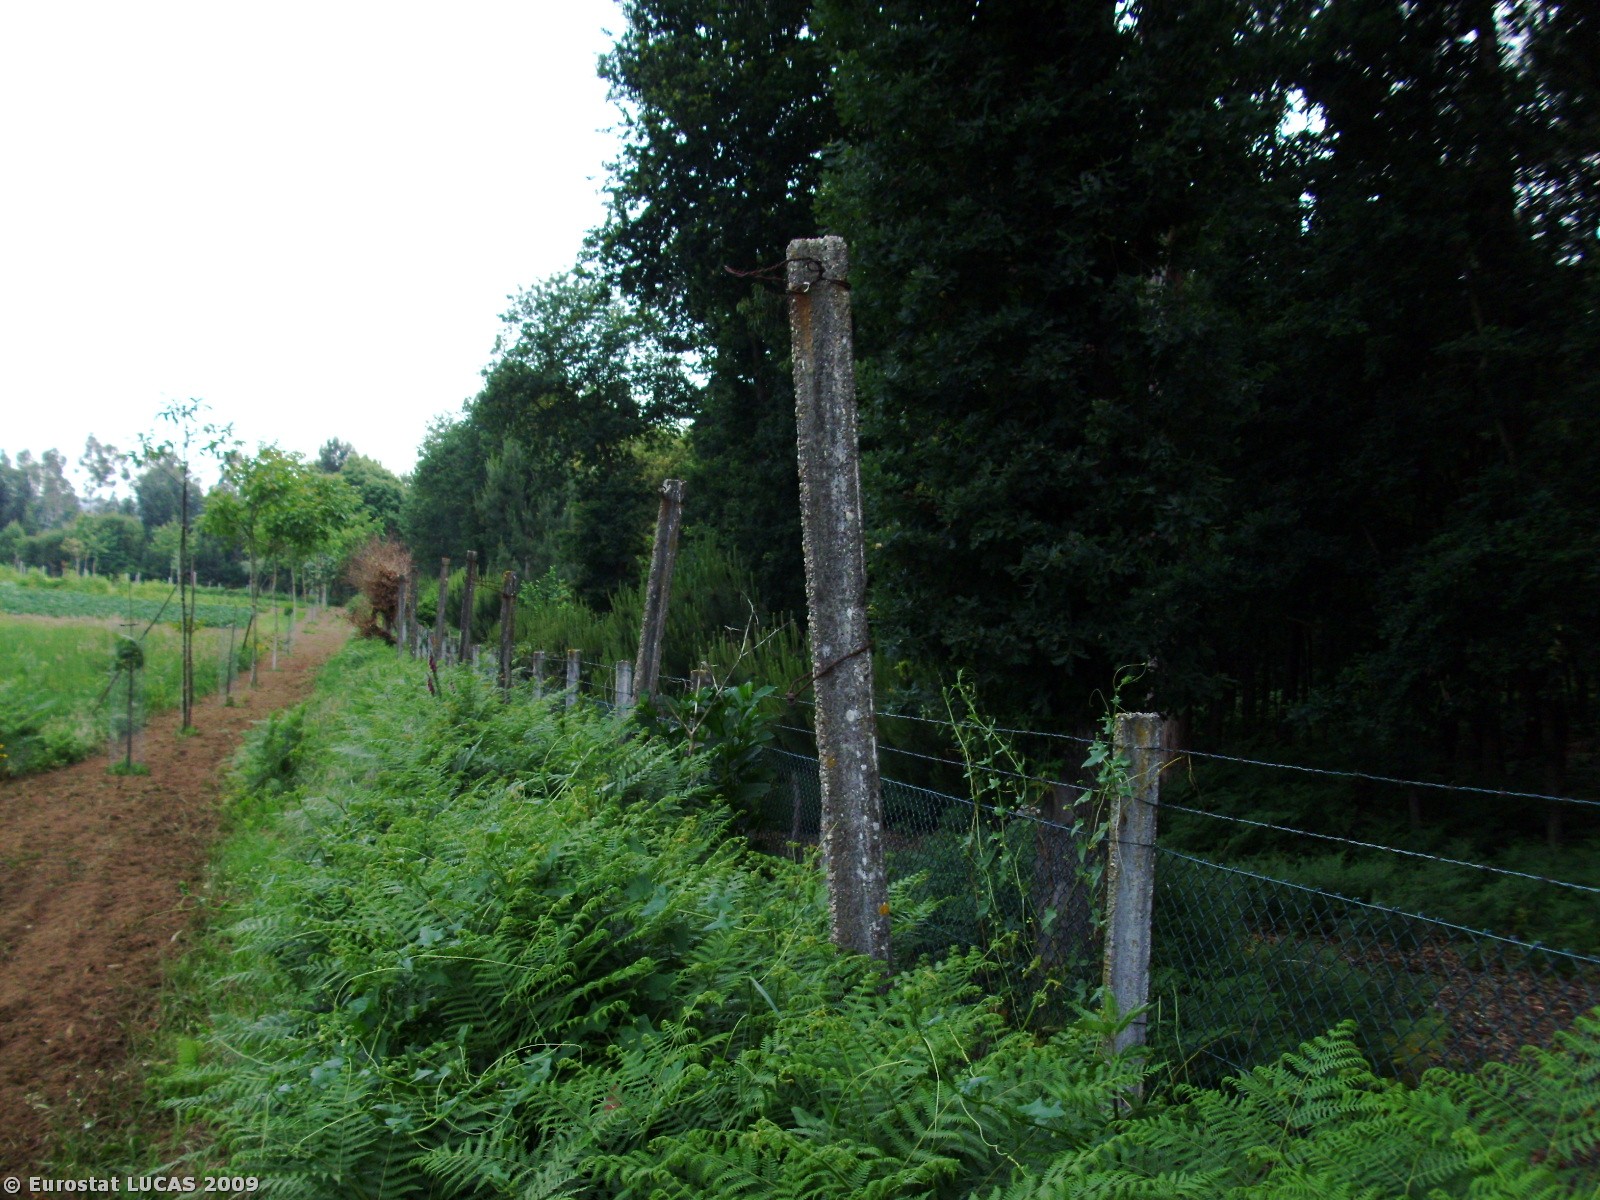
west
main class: Woodland
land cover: Broadleaved woodland
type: plantations and self-sown exotic forest
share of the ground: > 75 %
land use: Forestry
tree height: > 5 m
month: May
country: PT
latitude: 41.0904
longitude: -8.5424
